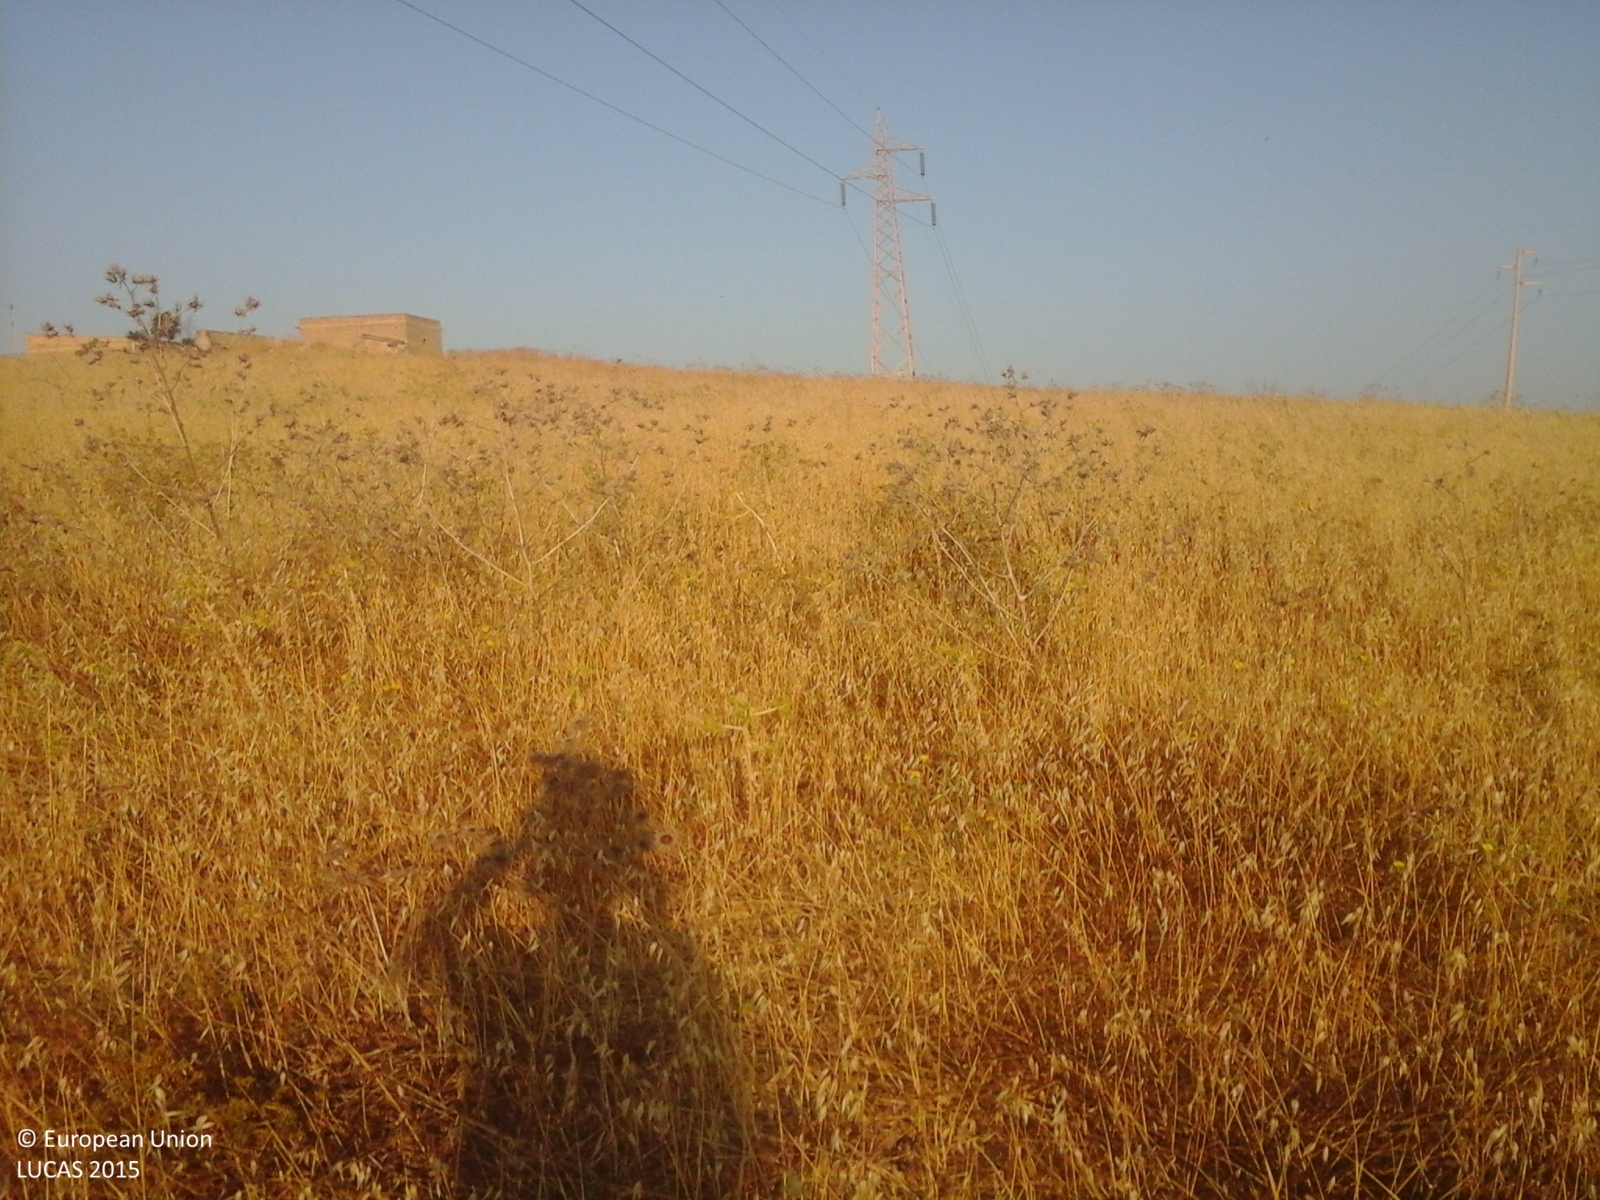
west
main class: Grassland
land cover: Spontaneously vegetated surfaces
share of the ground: > 75 %
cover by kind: herbaceous plants 100 %
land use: Fallow land
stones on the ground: > 50 %
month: July
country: IT
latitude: 37.1205
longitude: 13.9417
